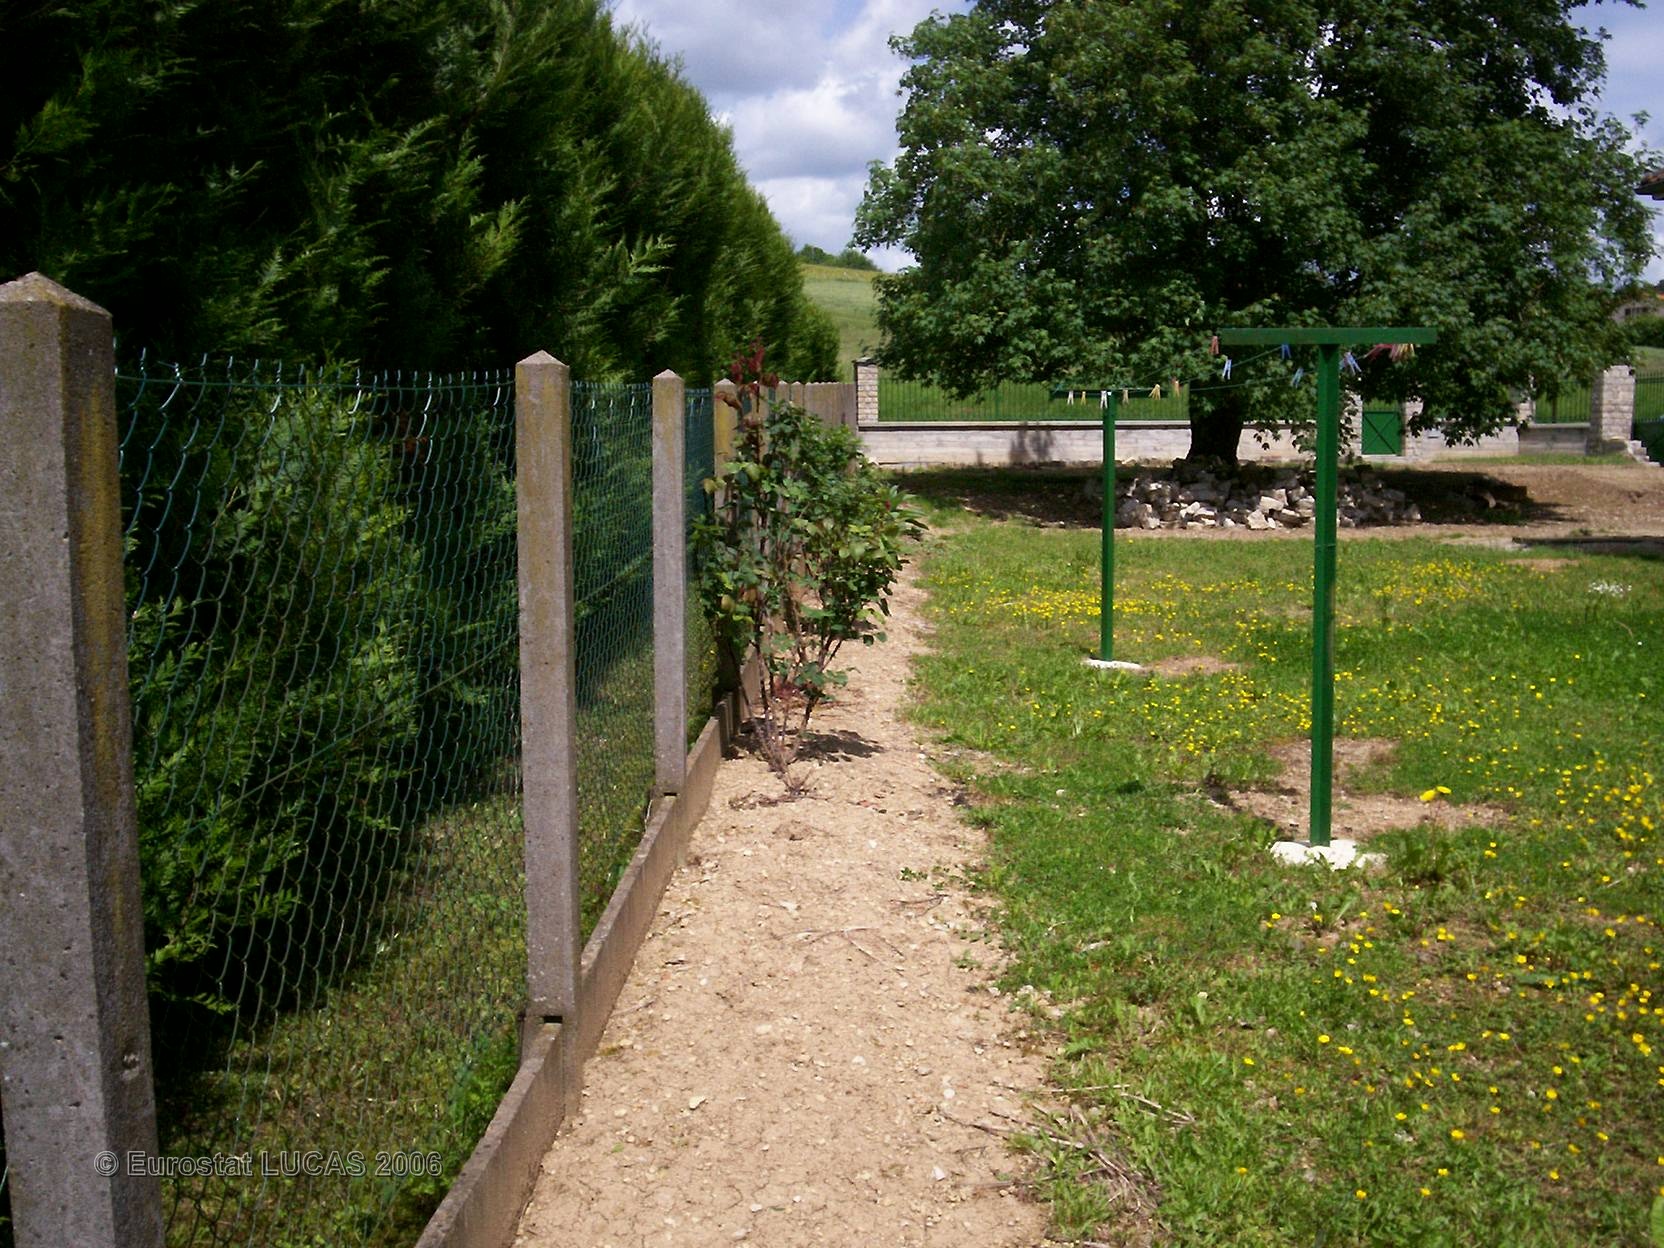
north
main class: Grassland
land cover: Grassland with sparse tree/shrub cover
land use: Residential
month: March
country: FR
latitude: 48.1431
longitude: 4.5548
